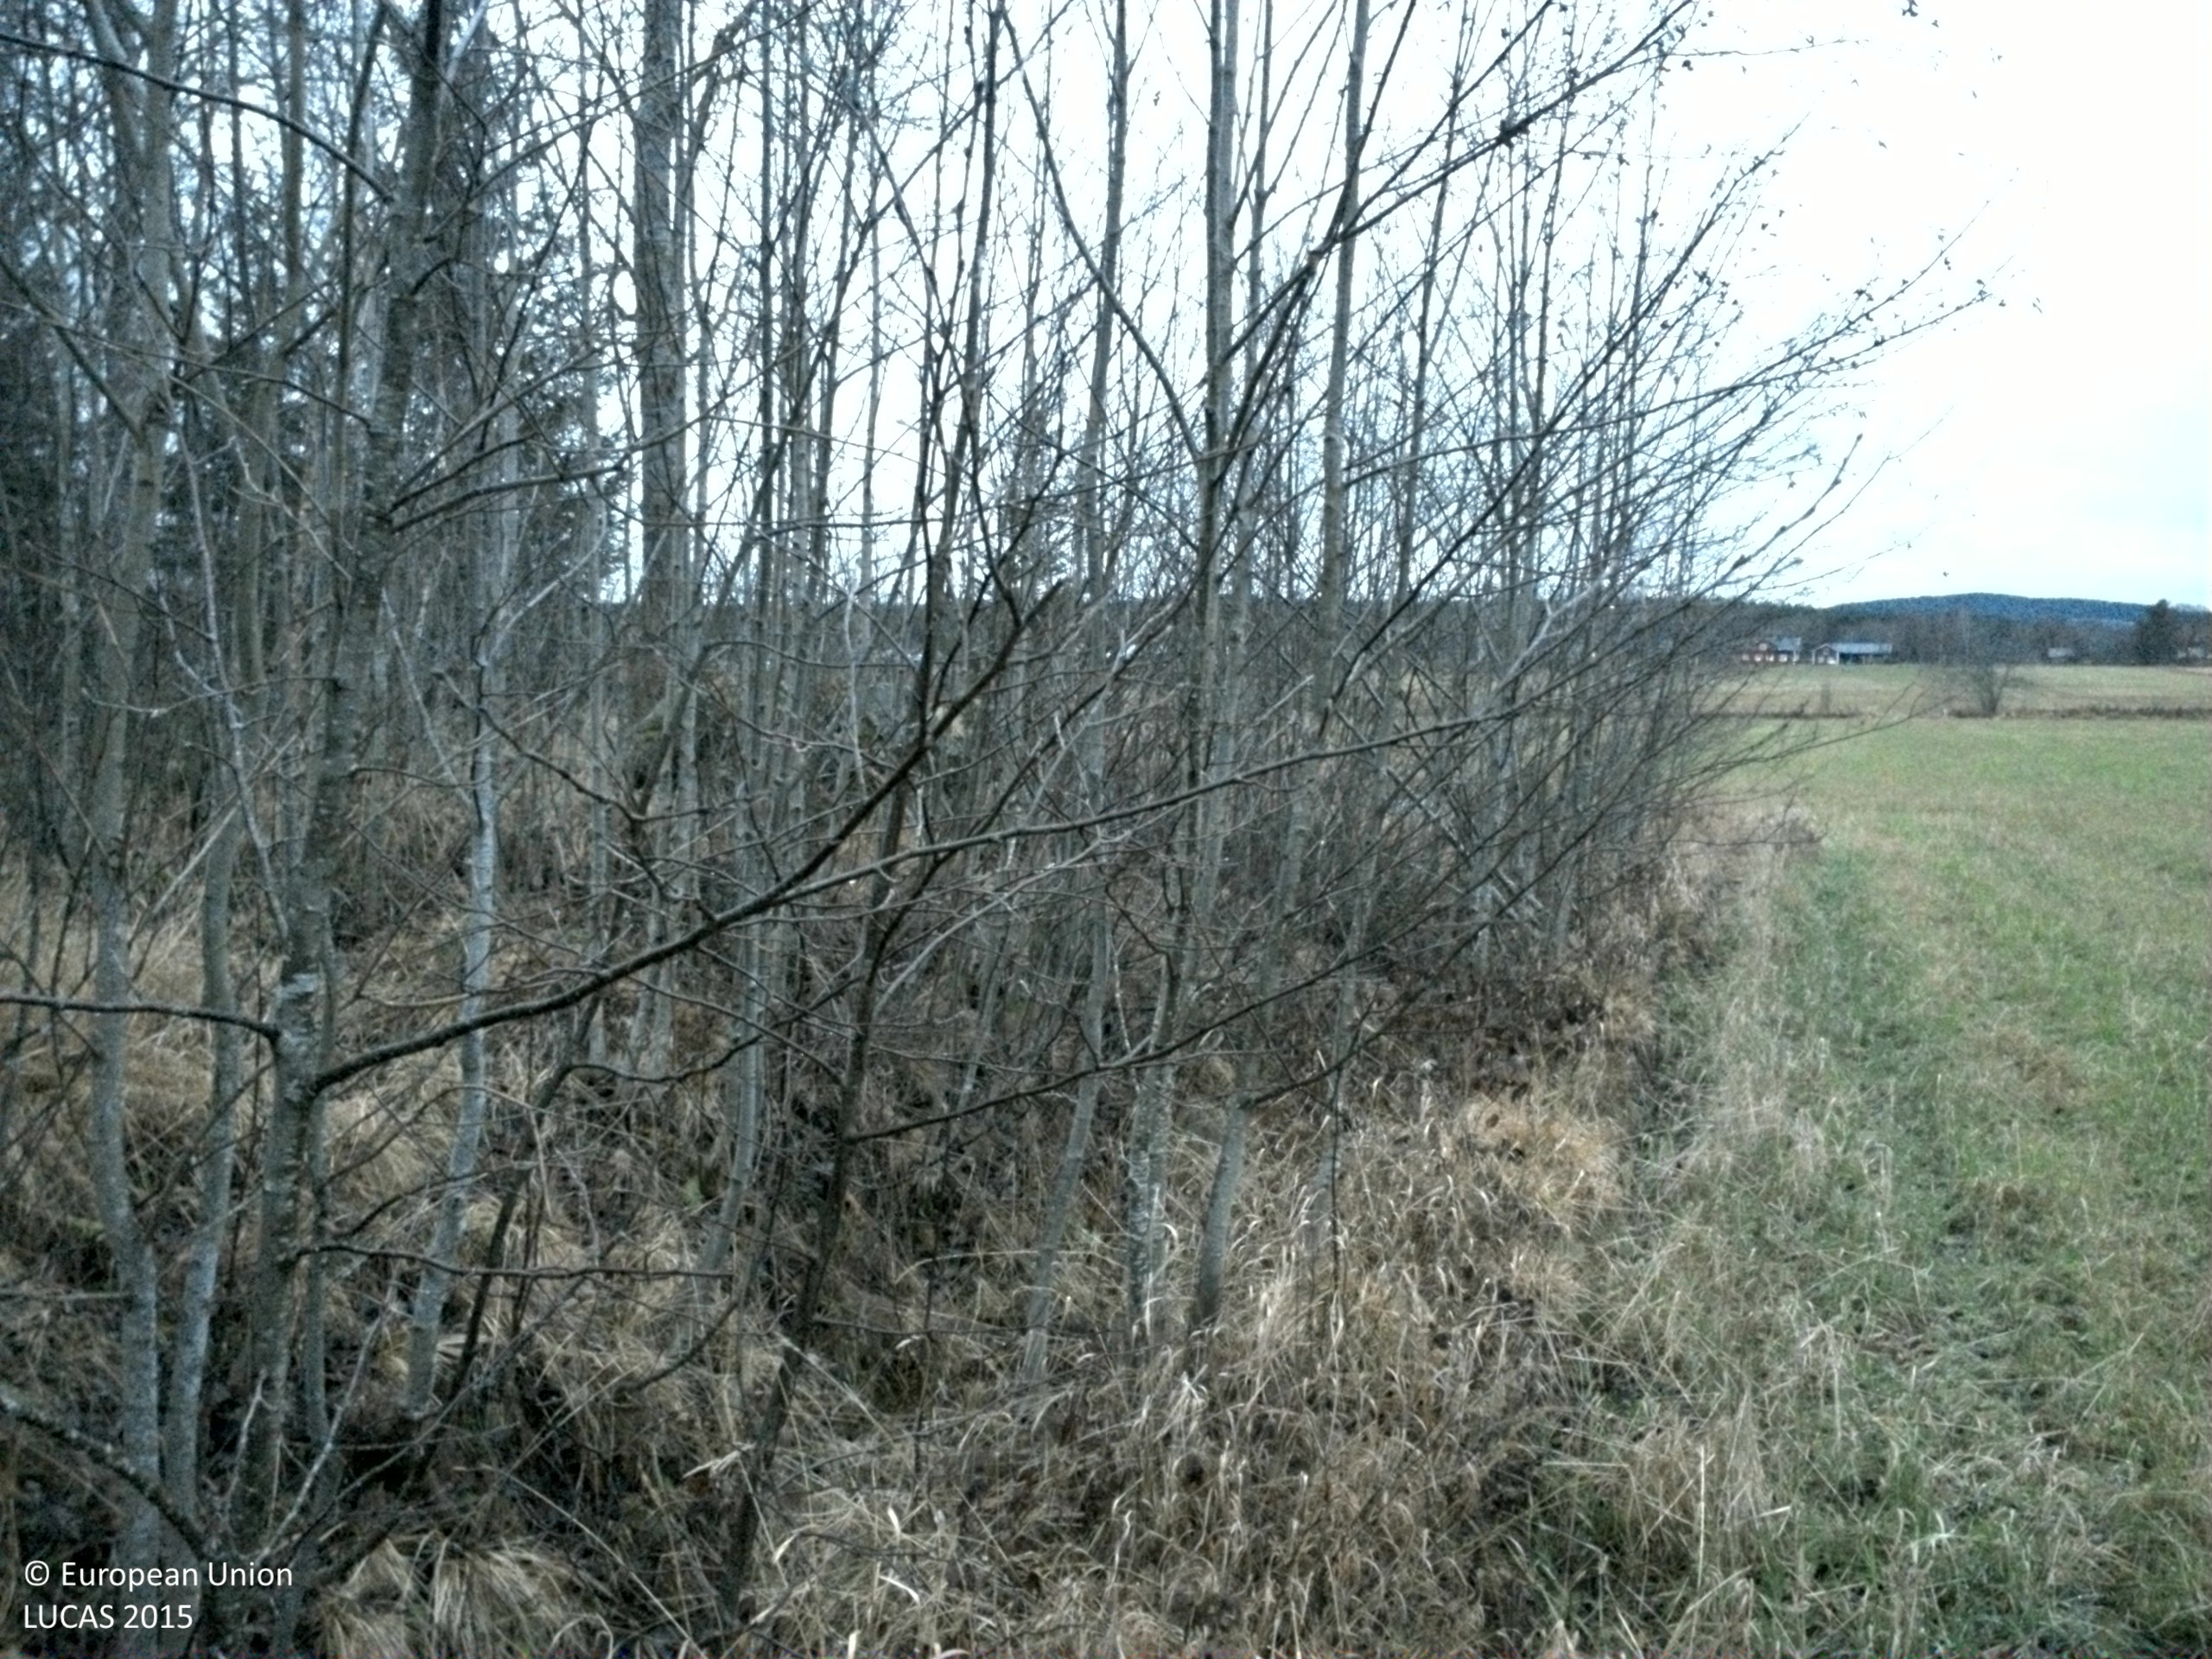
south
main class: Cropland
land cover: Other leguminous and mixtures for fodder
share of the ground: > 75 %
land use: Agriculture (excluding fallow land and kitchen gardens)
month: November
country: SE
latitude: 61.4923
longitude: 16.9529
